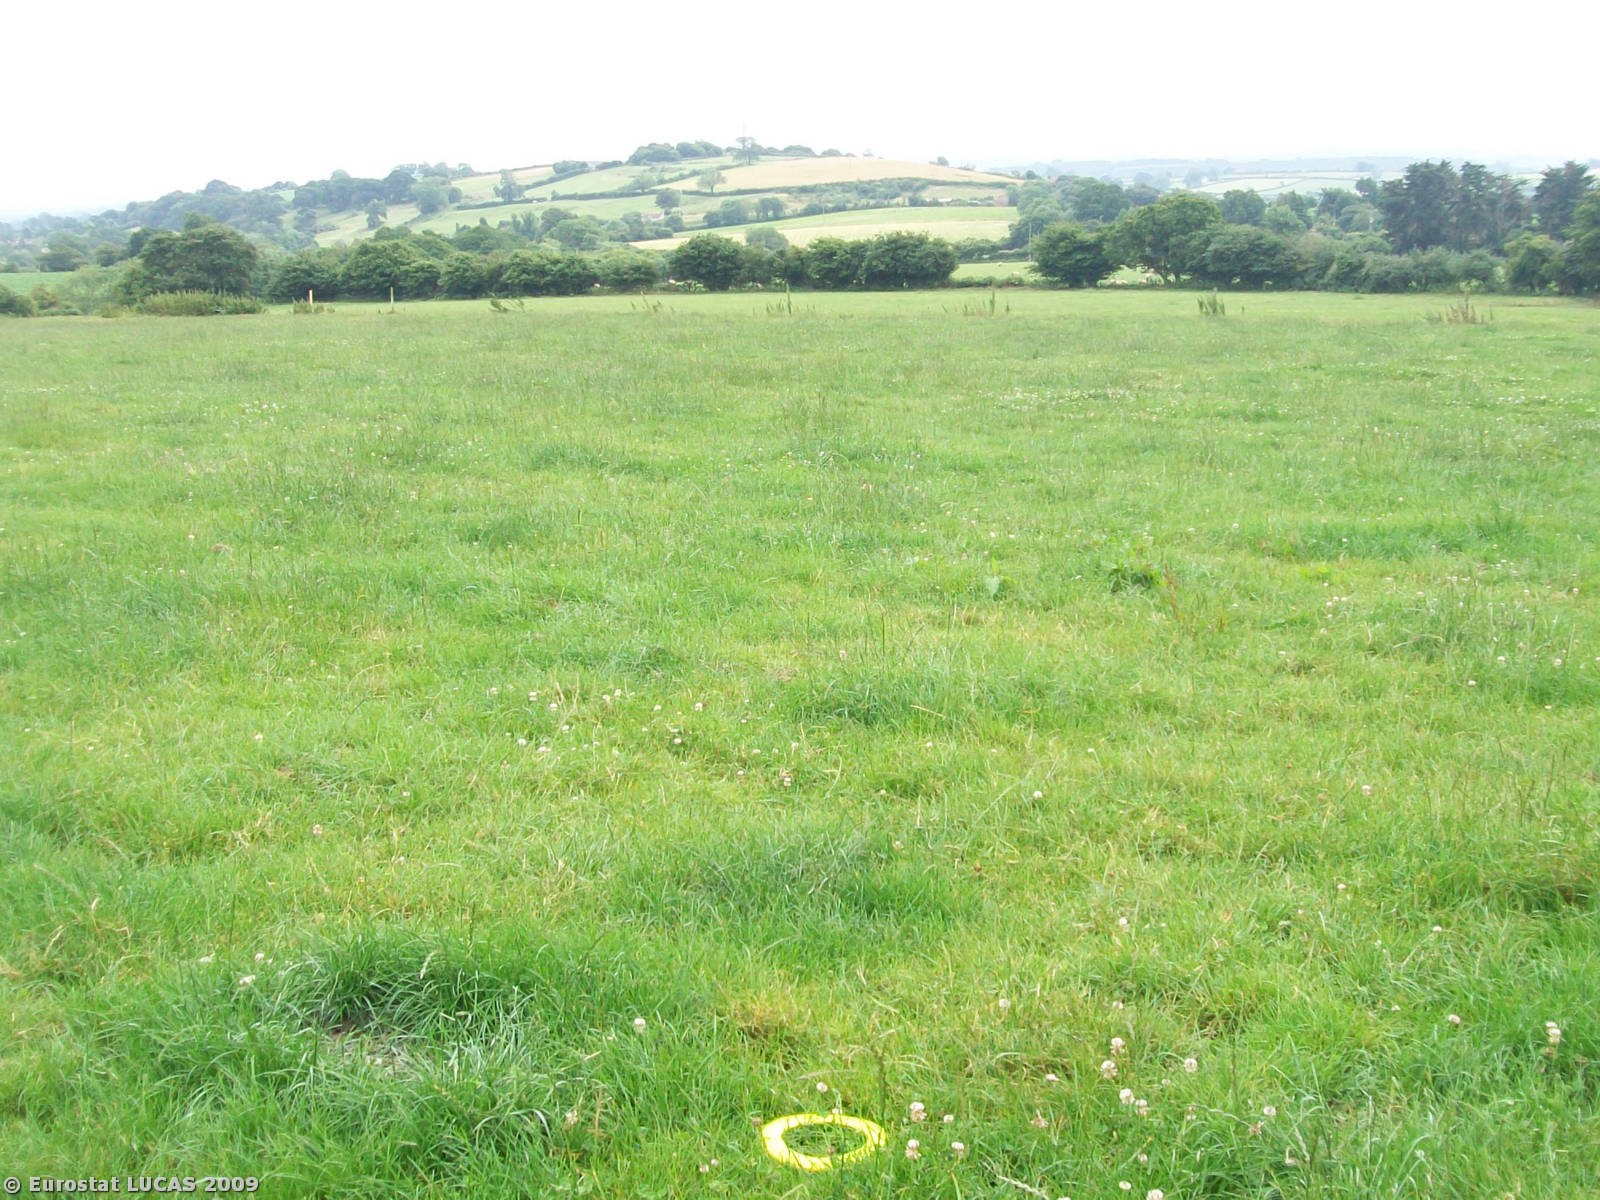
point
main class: Grassland
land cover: Grassland without tree/shrub cover
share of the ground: > 75 %
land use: Agriculture (excluding fallow land and kitchen gardens)
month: July
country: GB
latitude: 50.9252
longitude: -2.7175
